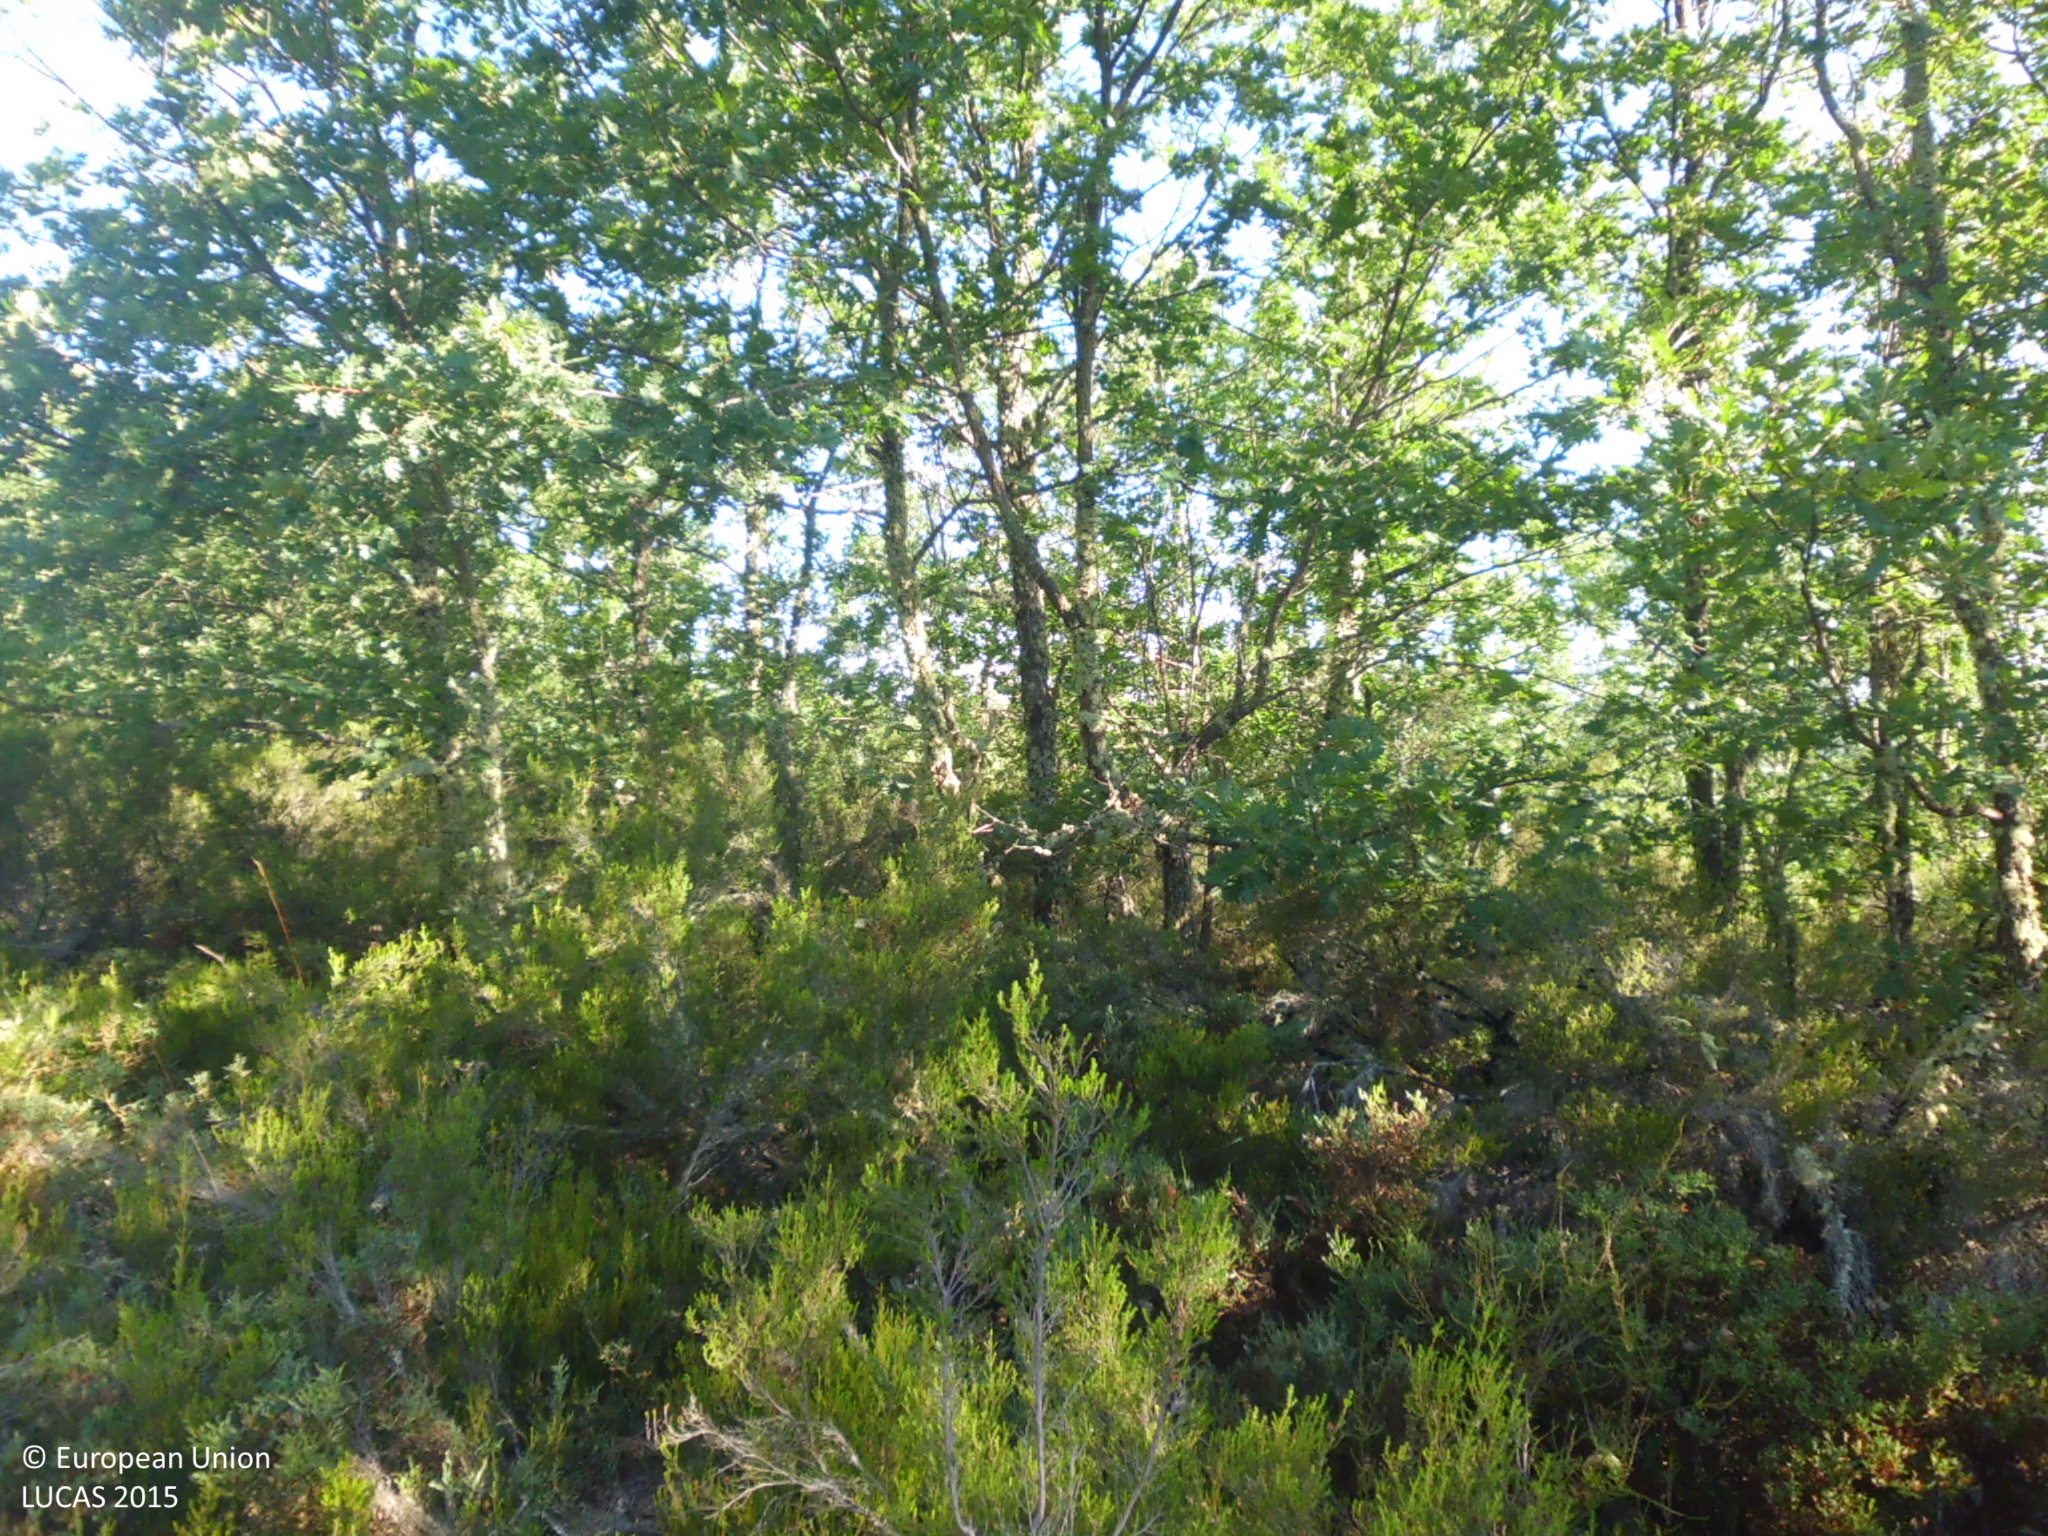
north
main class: Woodland
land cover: Broadleaved woodland
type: acidophilous oak and oak-birch forest
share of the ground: 50 - 75 %
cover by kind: broadleaved forest trees 50 %, shrubs 50 %
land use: Semi-natural and natural areas not in use
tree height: > 5 m
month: June
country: ES
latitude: 42.6793
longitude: -5.0366
